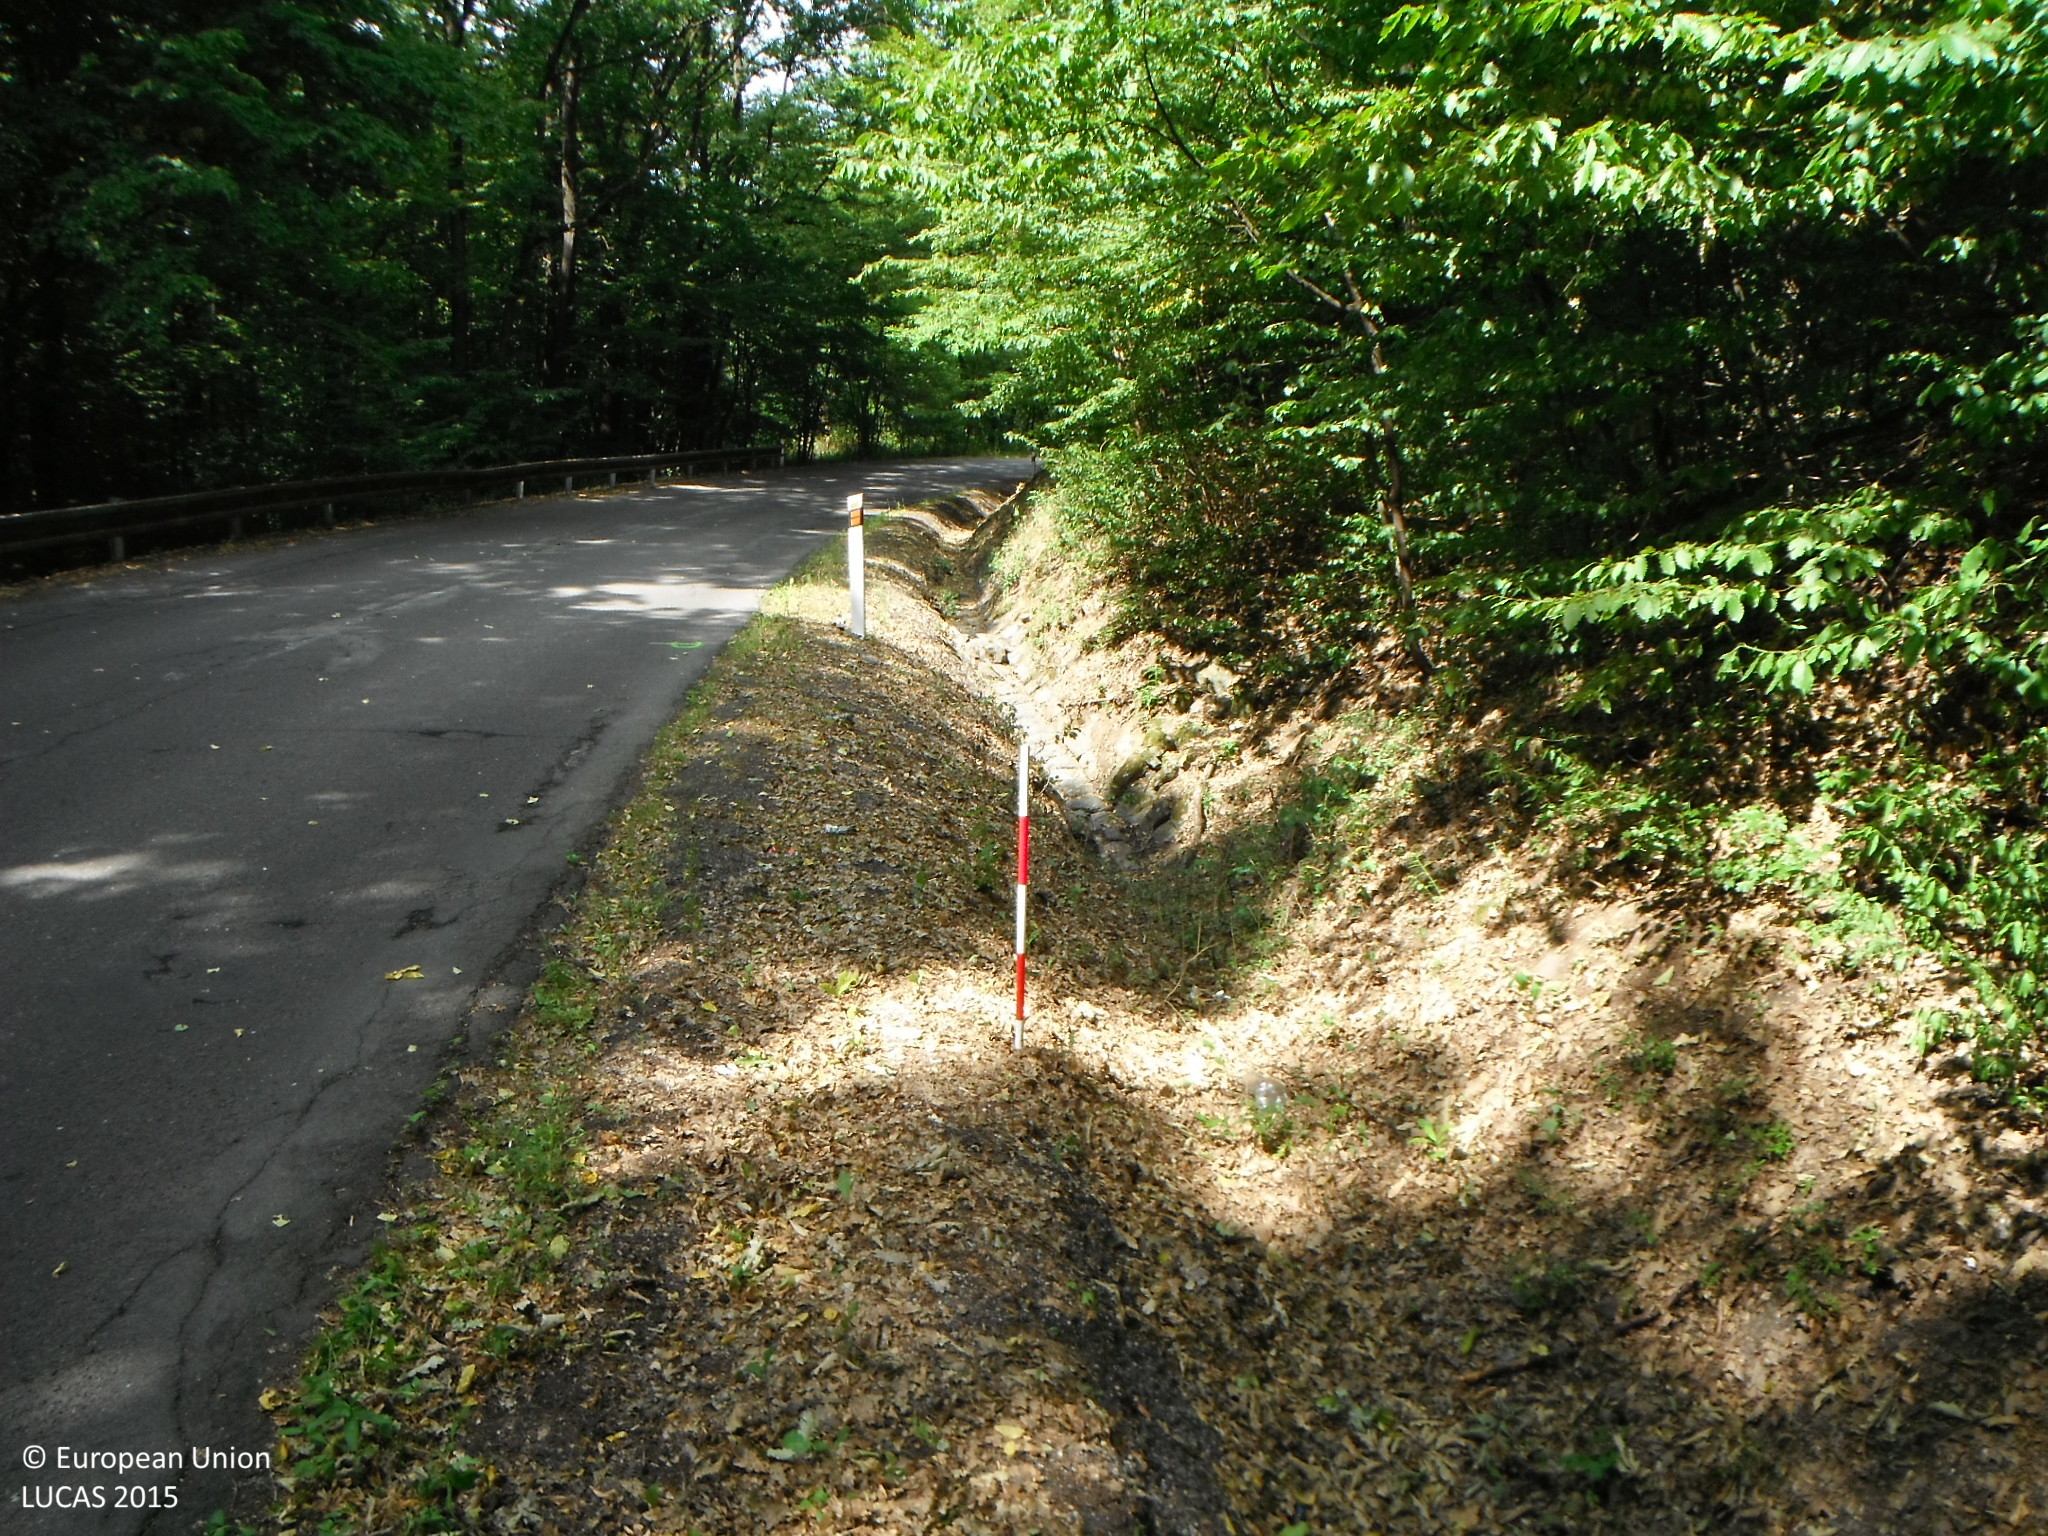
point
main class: Woodland
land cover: Broadleaved woodland
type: mesophytic deciduous forest
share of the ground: > 75 %
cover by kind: broadleaved forest trees 100 %
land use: Forestry
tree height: > 5 m
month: July
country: SK
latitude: 48.3198
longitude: 19.0698
